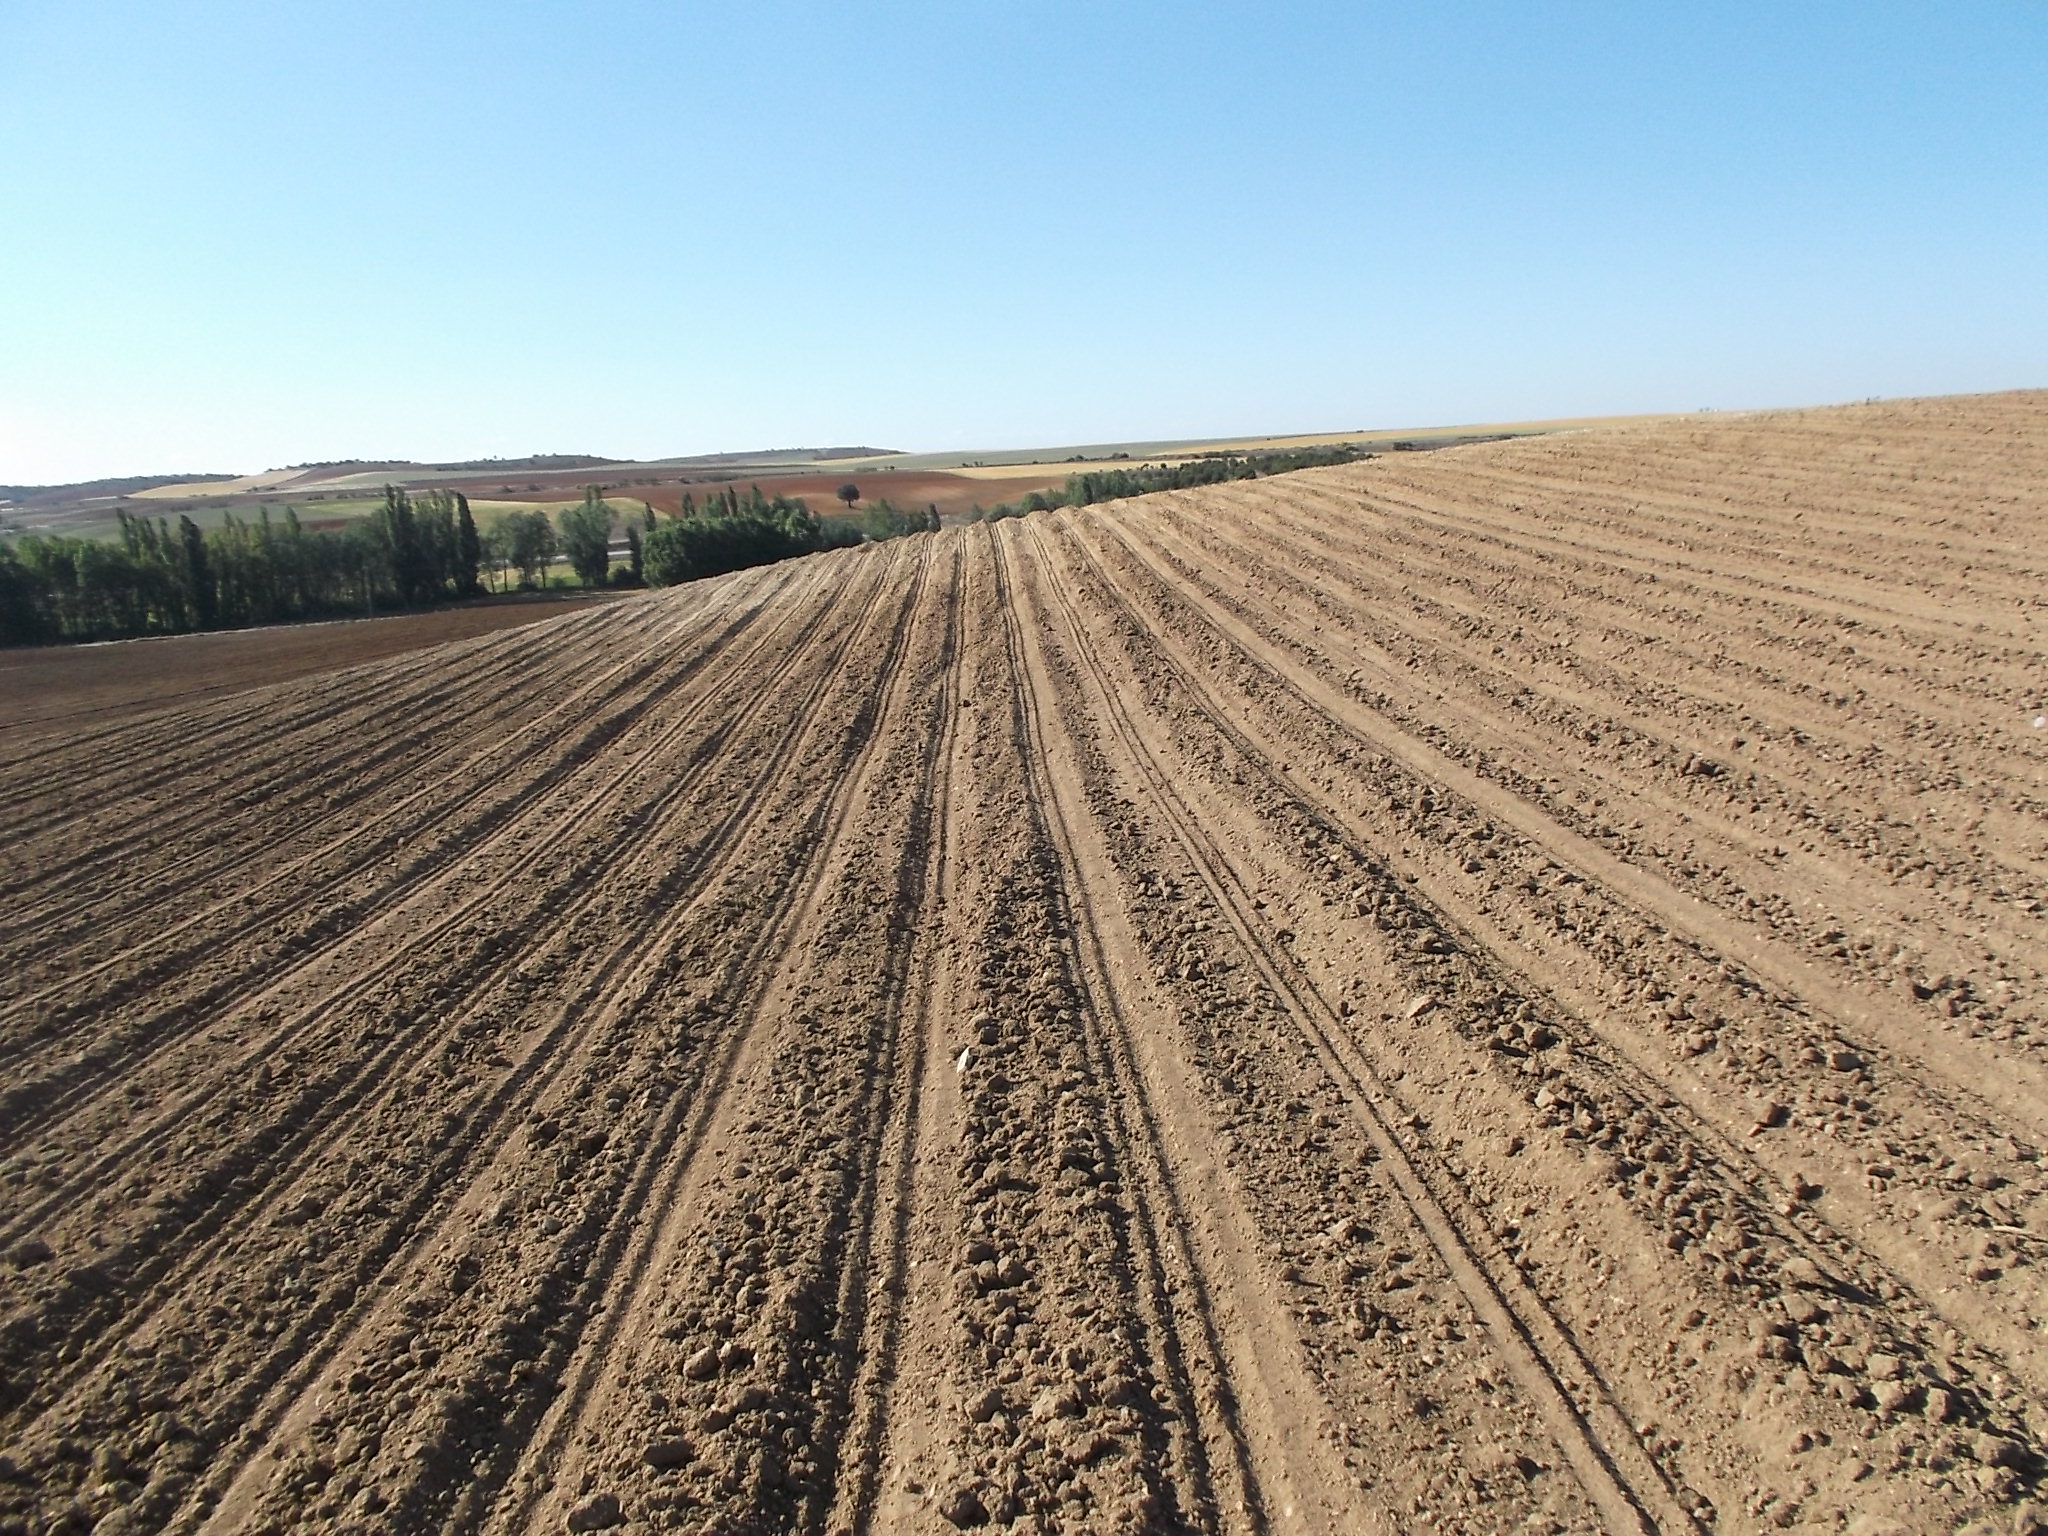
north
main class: Cropland
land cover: Sunflower
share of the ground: < 10 %
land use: Agriculture (excluding fallow land and kitchen gardens)
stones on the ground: < 10 %
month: May
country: ES
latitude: 41.1579
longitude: -5.3879
